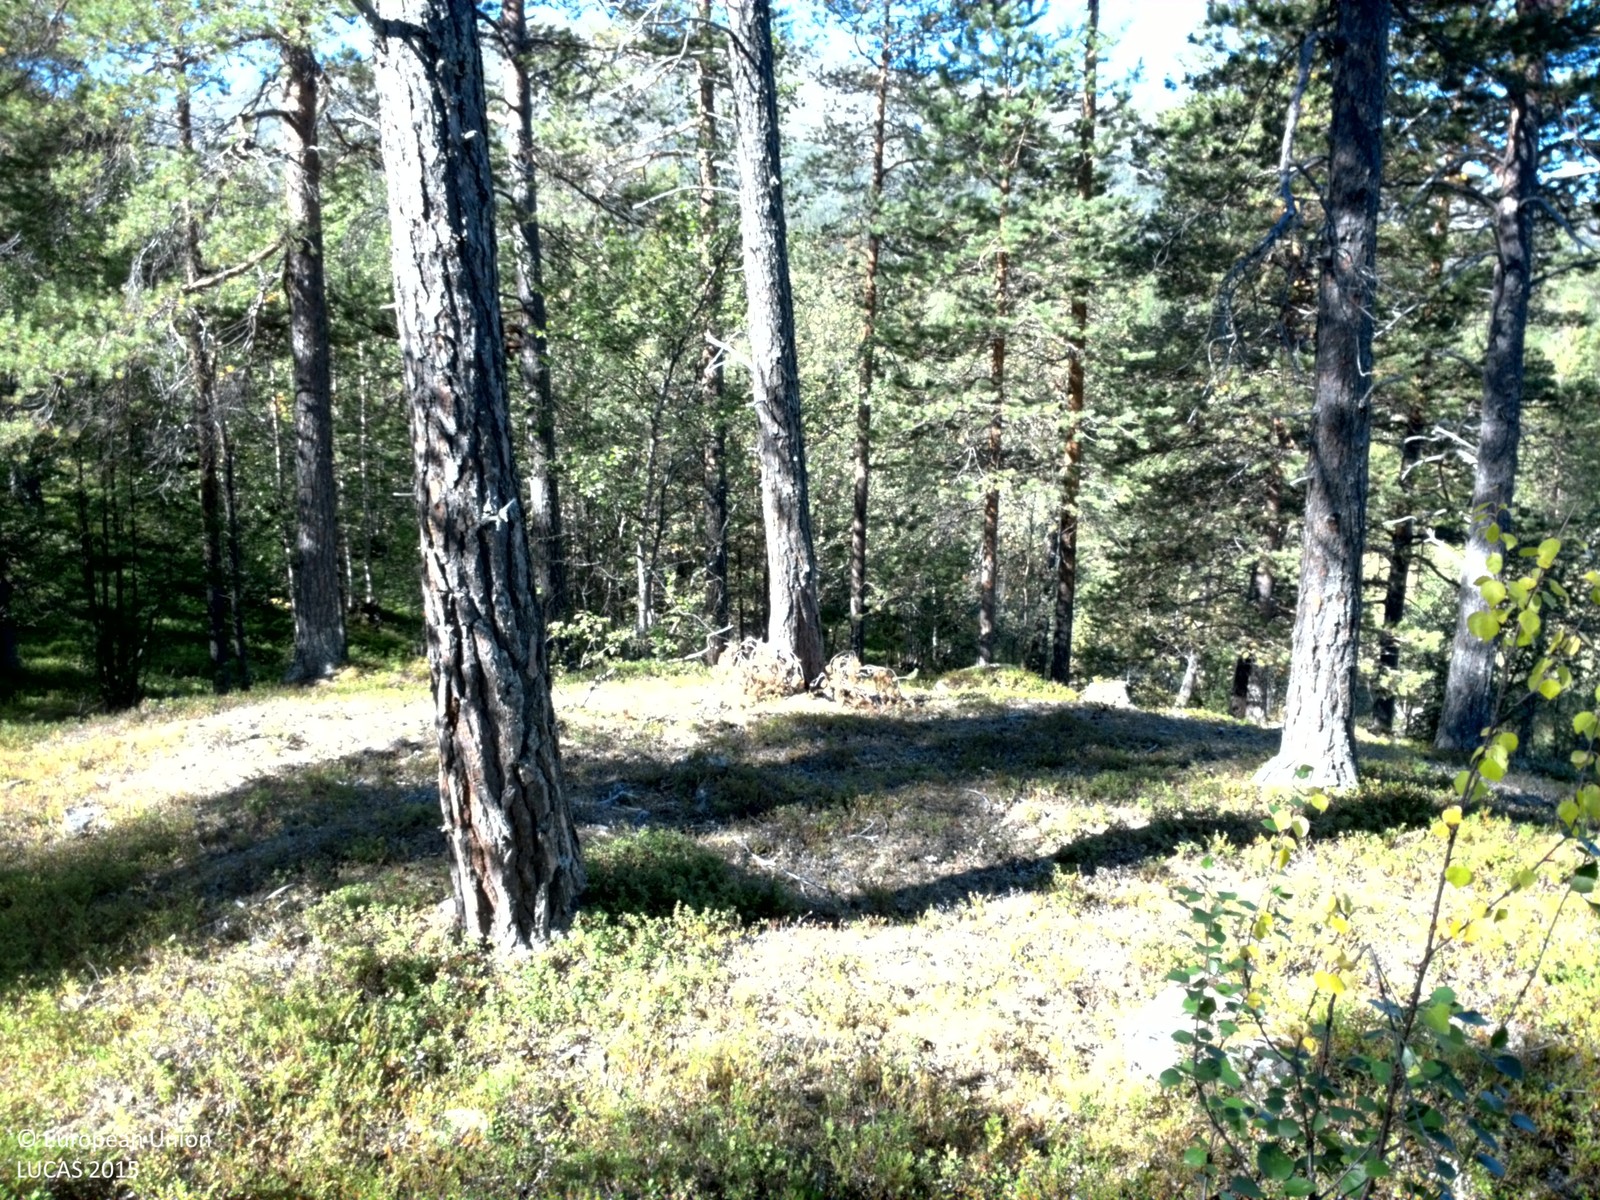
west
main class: Woodland
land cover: Pine dominated coniferous woodland
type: boreal forest
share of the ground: 25 - 50 %
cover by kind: shrubs 65 %, coniferous forest trees 25 %, broadleaved forest trees 5 %, consolidated bare surface 5 %
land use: Forestry
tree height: > 5 m
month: August
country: SE
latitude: 66.6333
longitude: 18.7393
